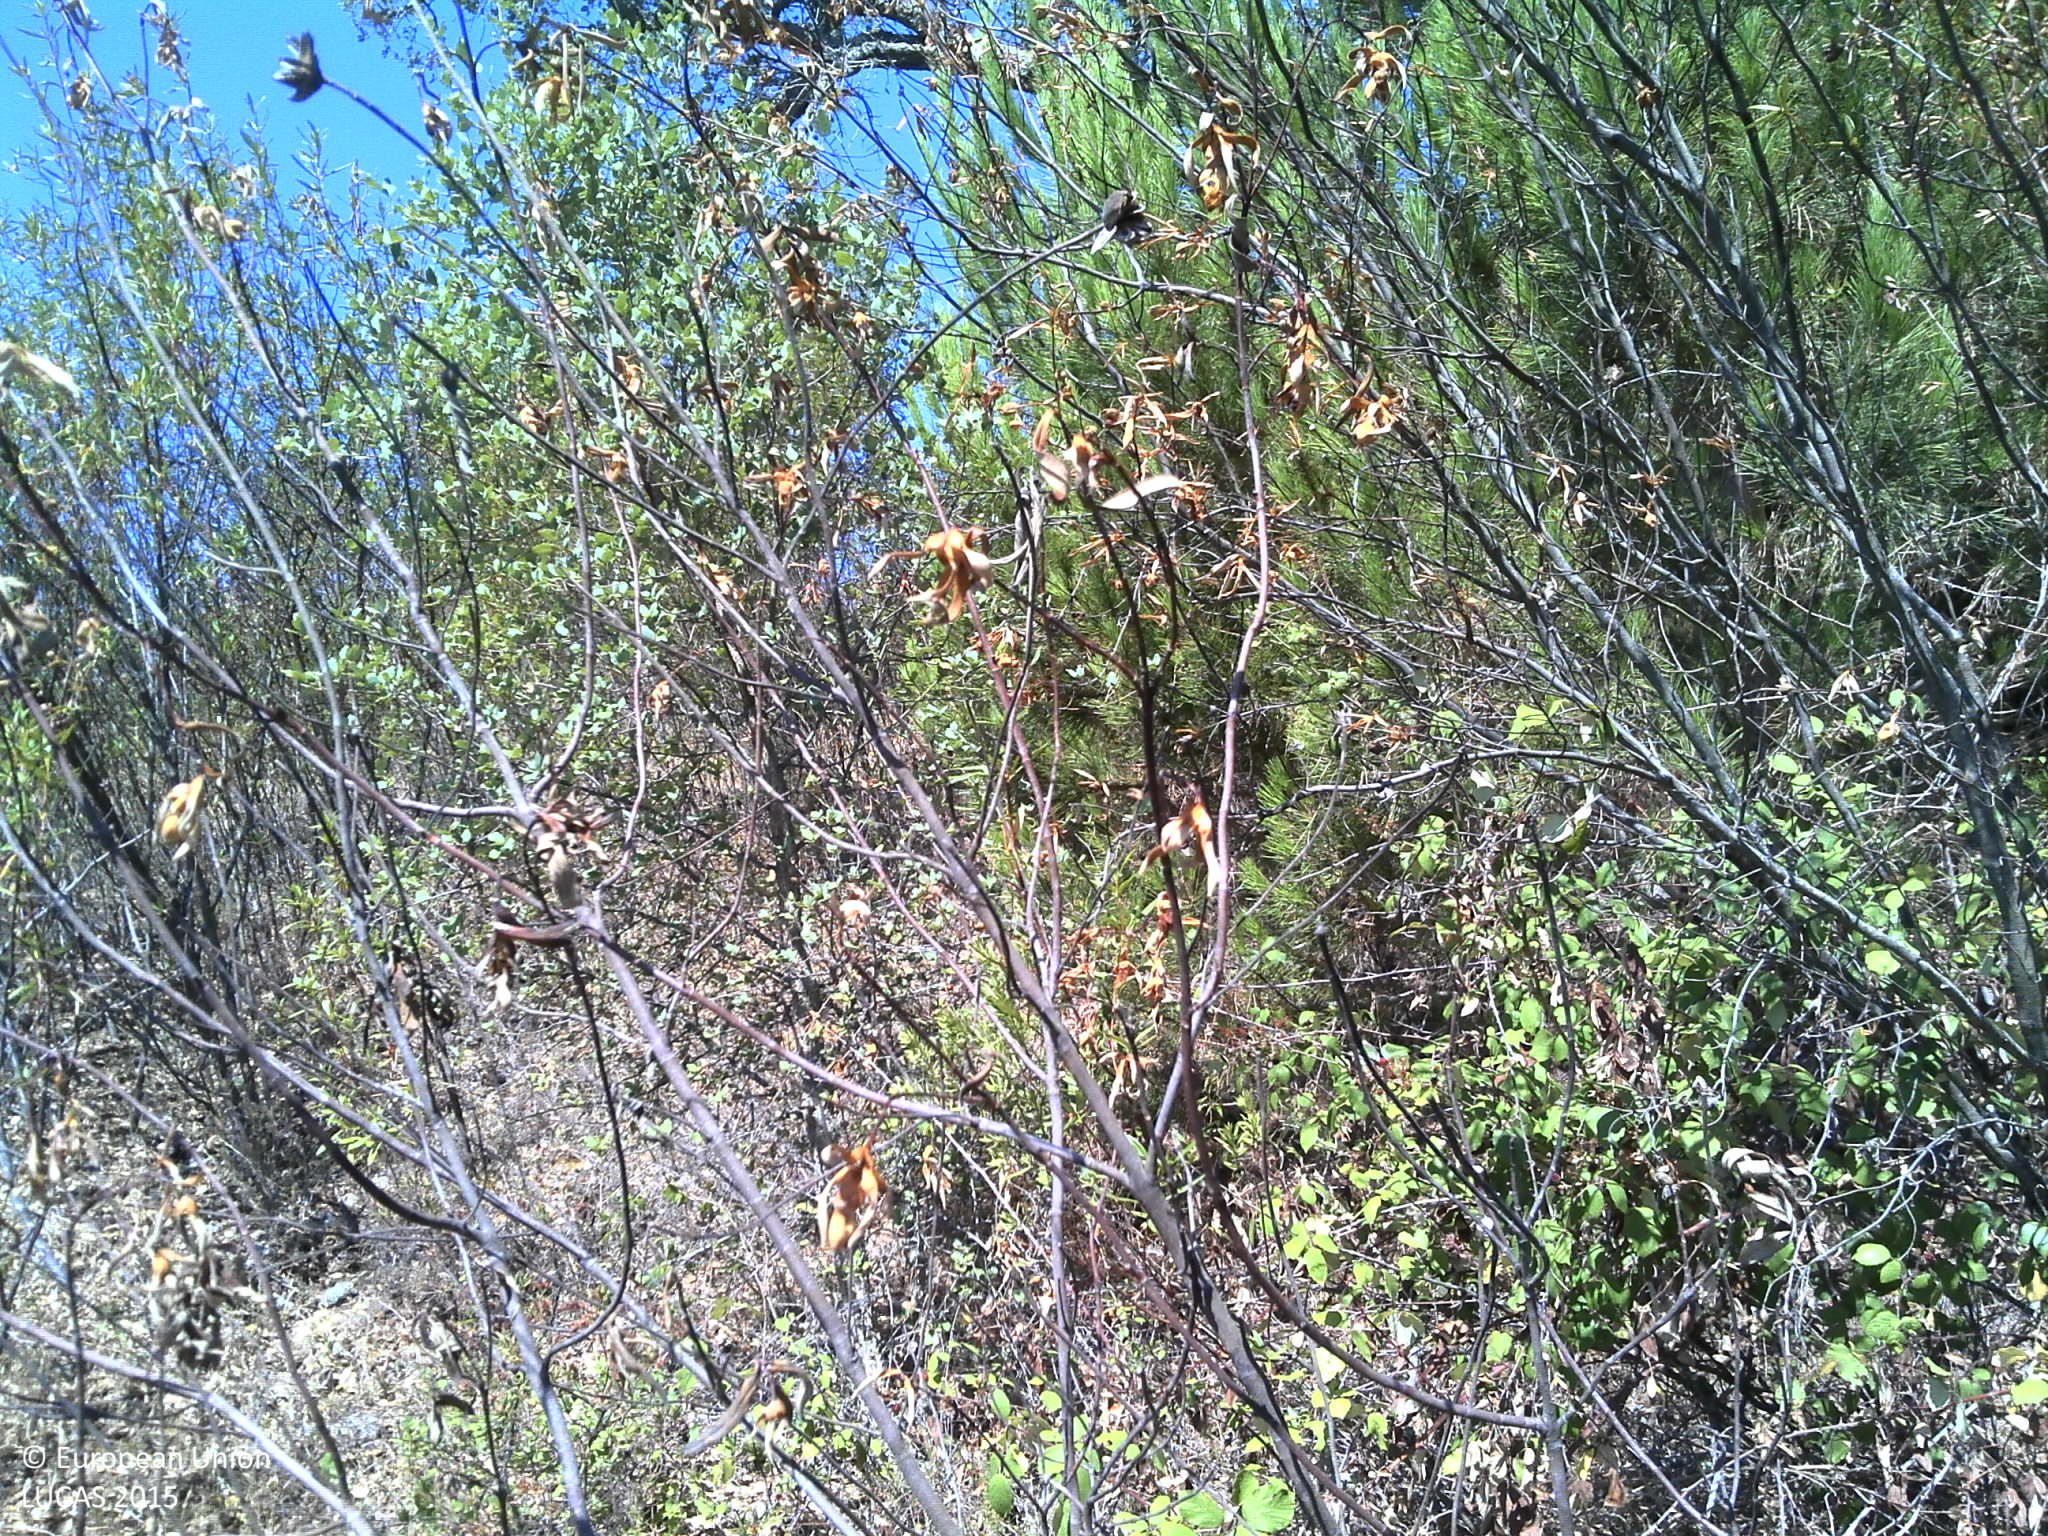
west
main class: Woodland
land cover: Pine dominated mixed woodland
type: coniferous forest of the mediterranean region
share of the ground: 10 - 25 %
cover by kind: shrubs 45 %, coniferous forest trees 25 %, unconsolidated bare surface 20 %, broadleaved forest trees 10 %
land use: Forestry
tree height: > 5 m
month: July
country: PT
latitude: 38.4862
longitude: -8.5222
